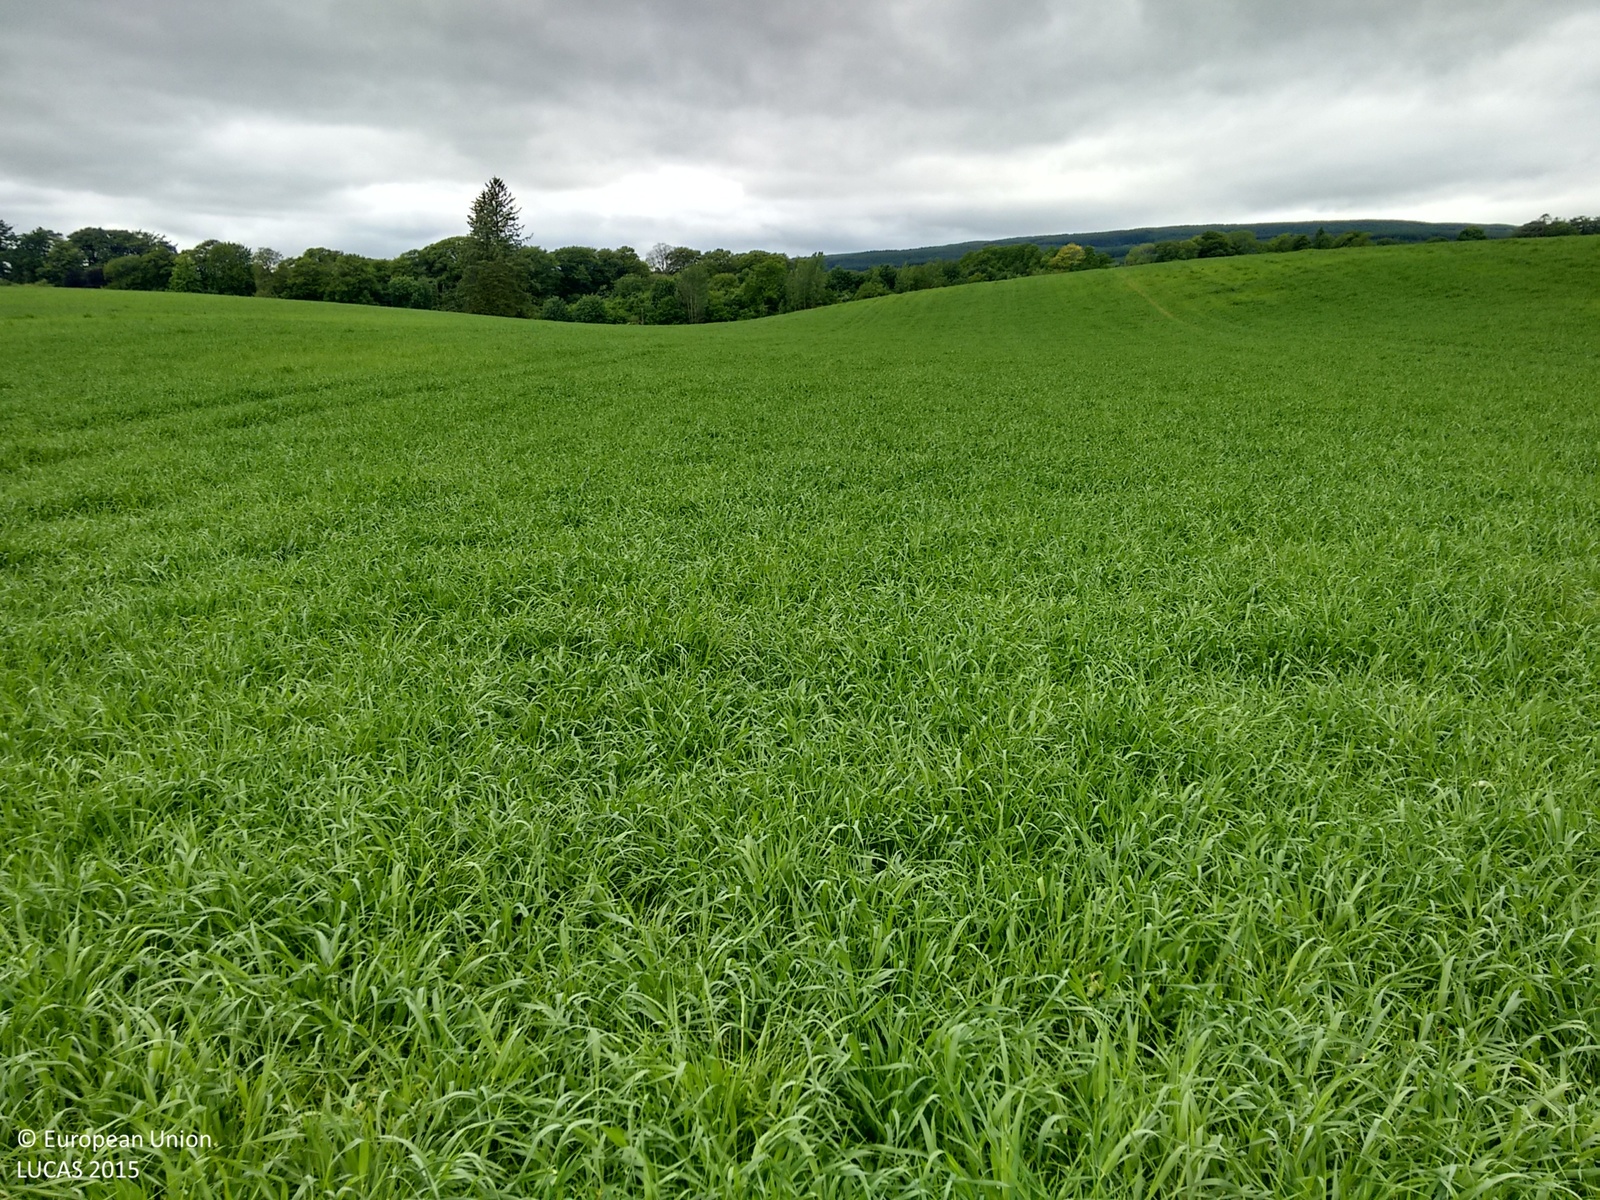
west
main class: Cropland
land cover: Temporary grasslands
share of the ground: > 75 %
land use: Agriculture (excluding fallow land and kitchen gardens)
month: June
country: GB
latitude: 55.1982
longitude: -3.4808
